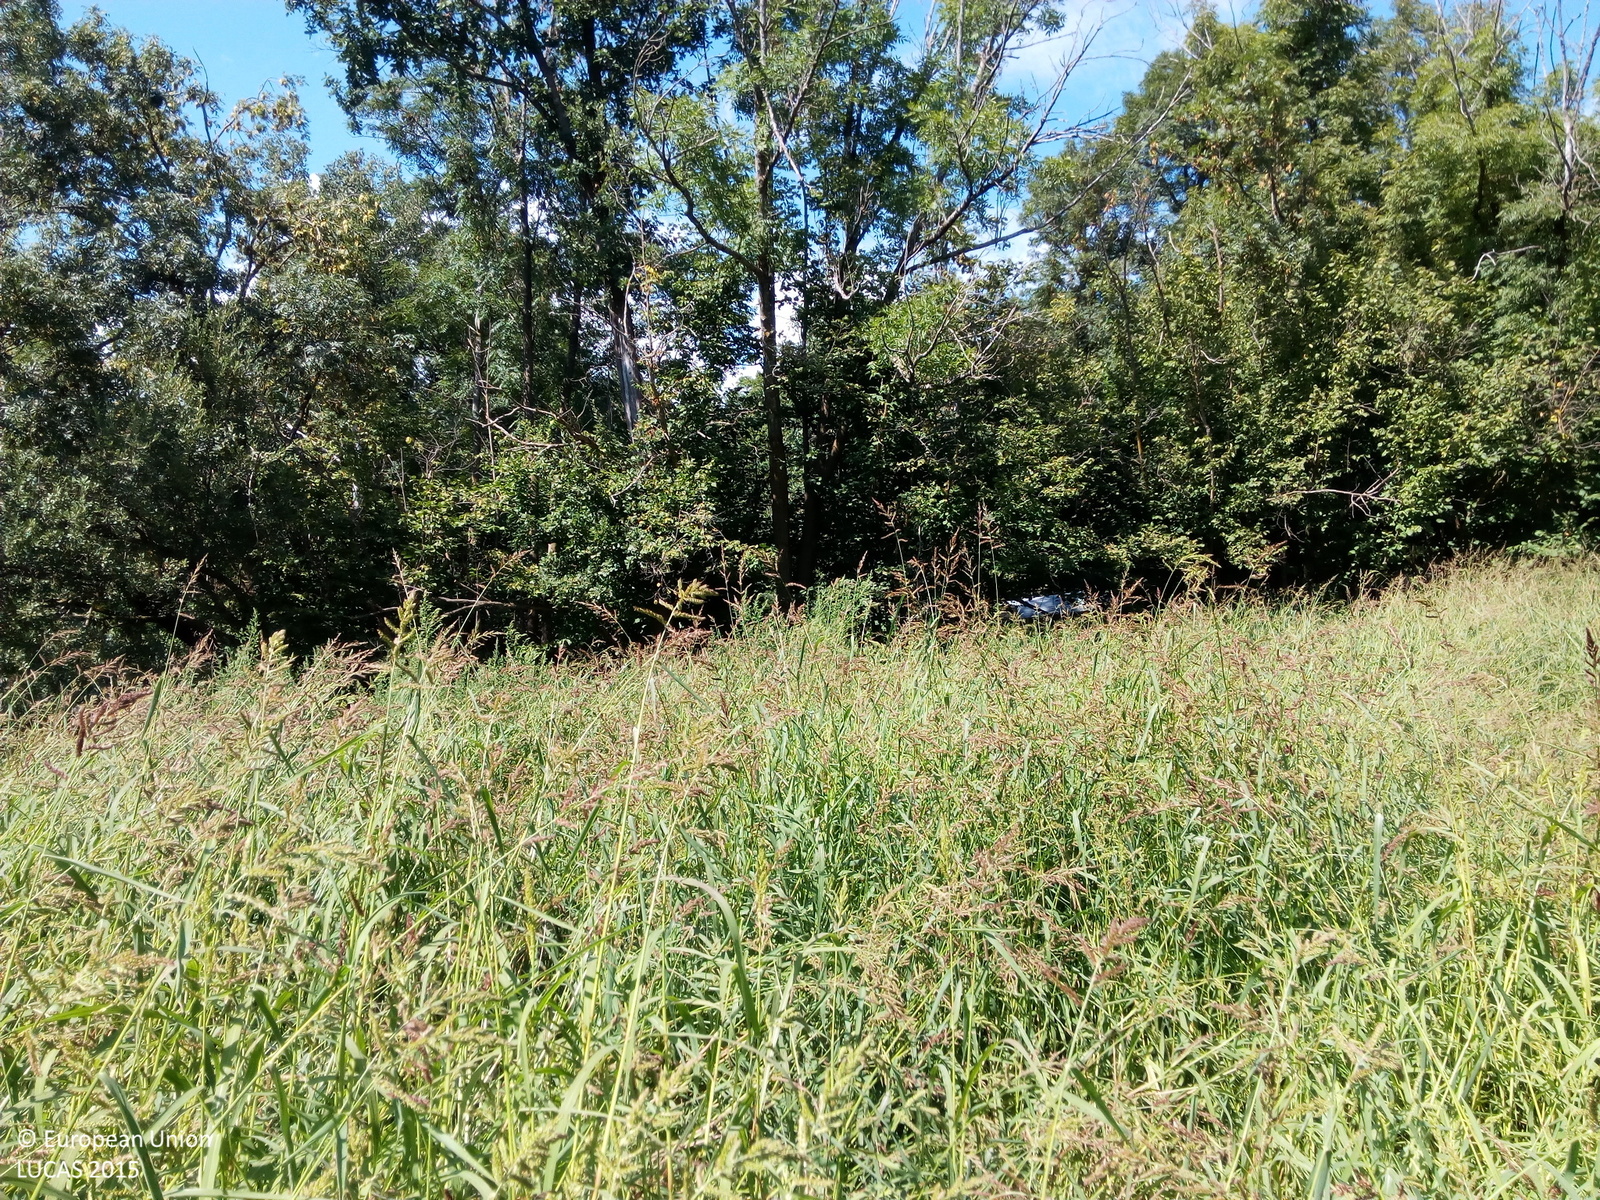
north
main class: Cropland
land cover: Other cereals
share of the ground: > 75 %
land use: Agriculture (excluding fallow land and kitchen gardens)
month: September
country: ES
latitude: 42.5154
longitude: 0.4986
